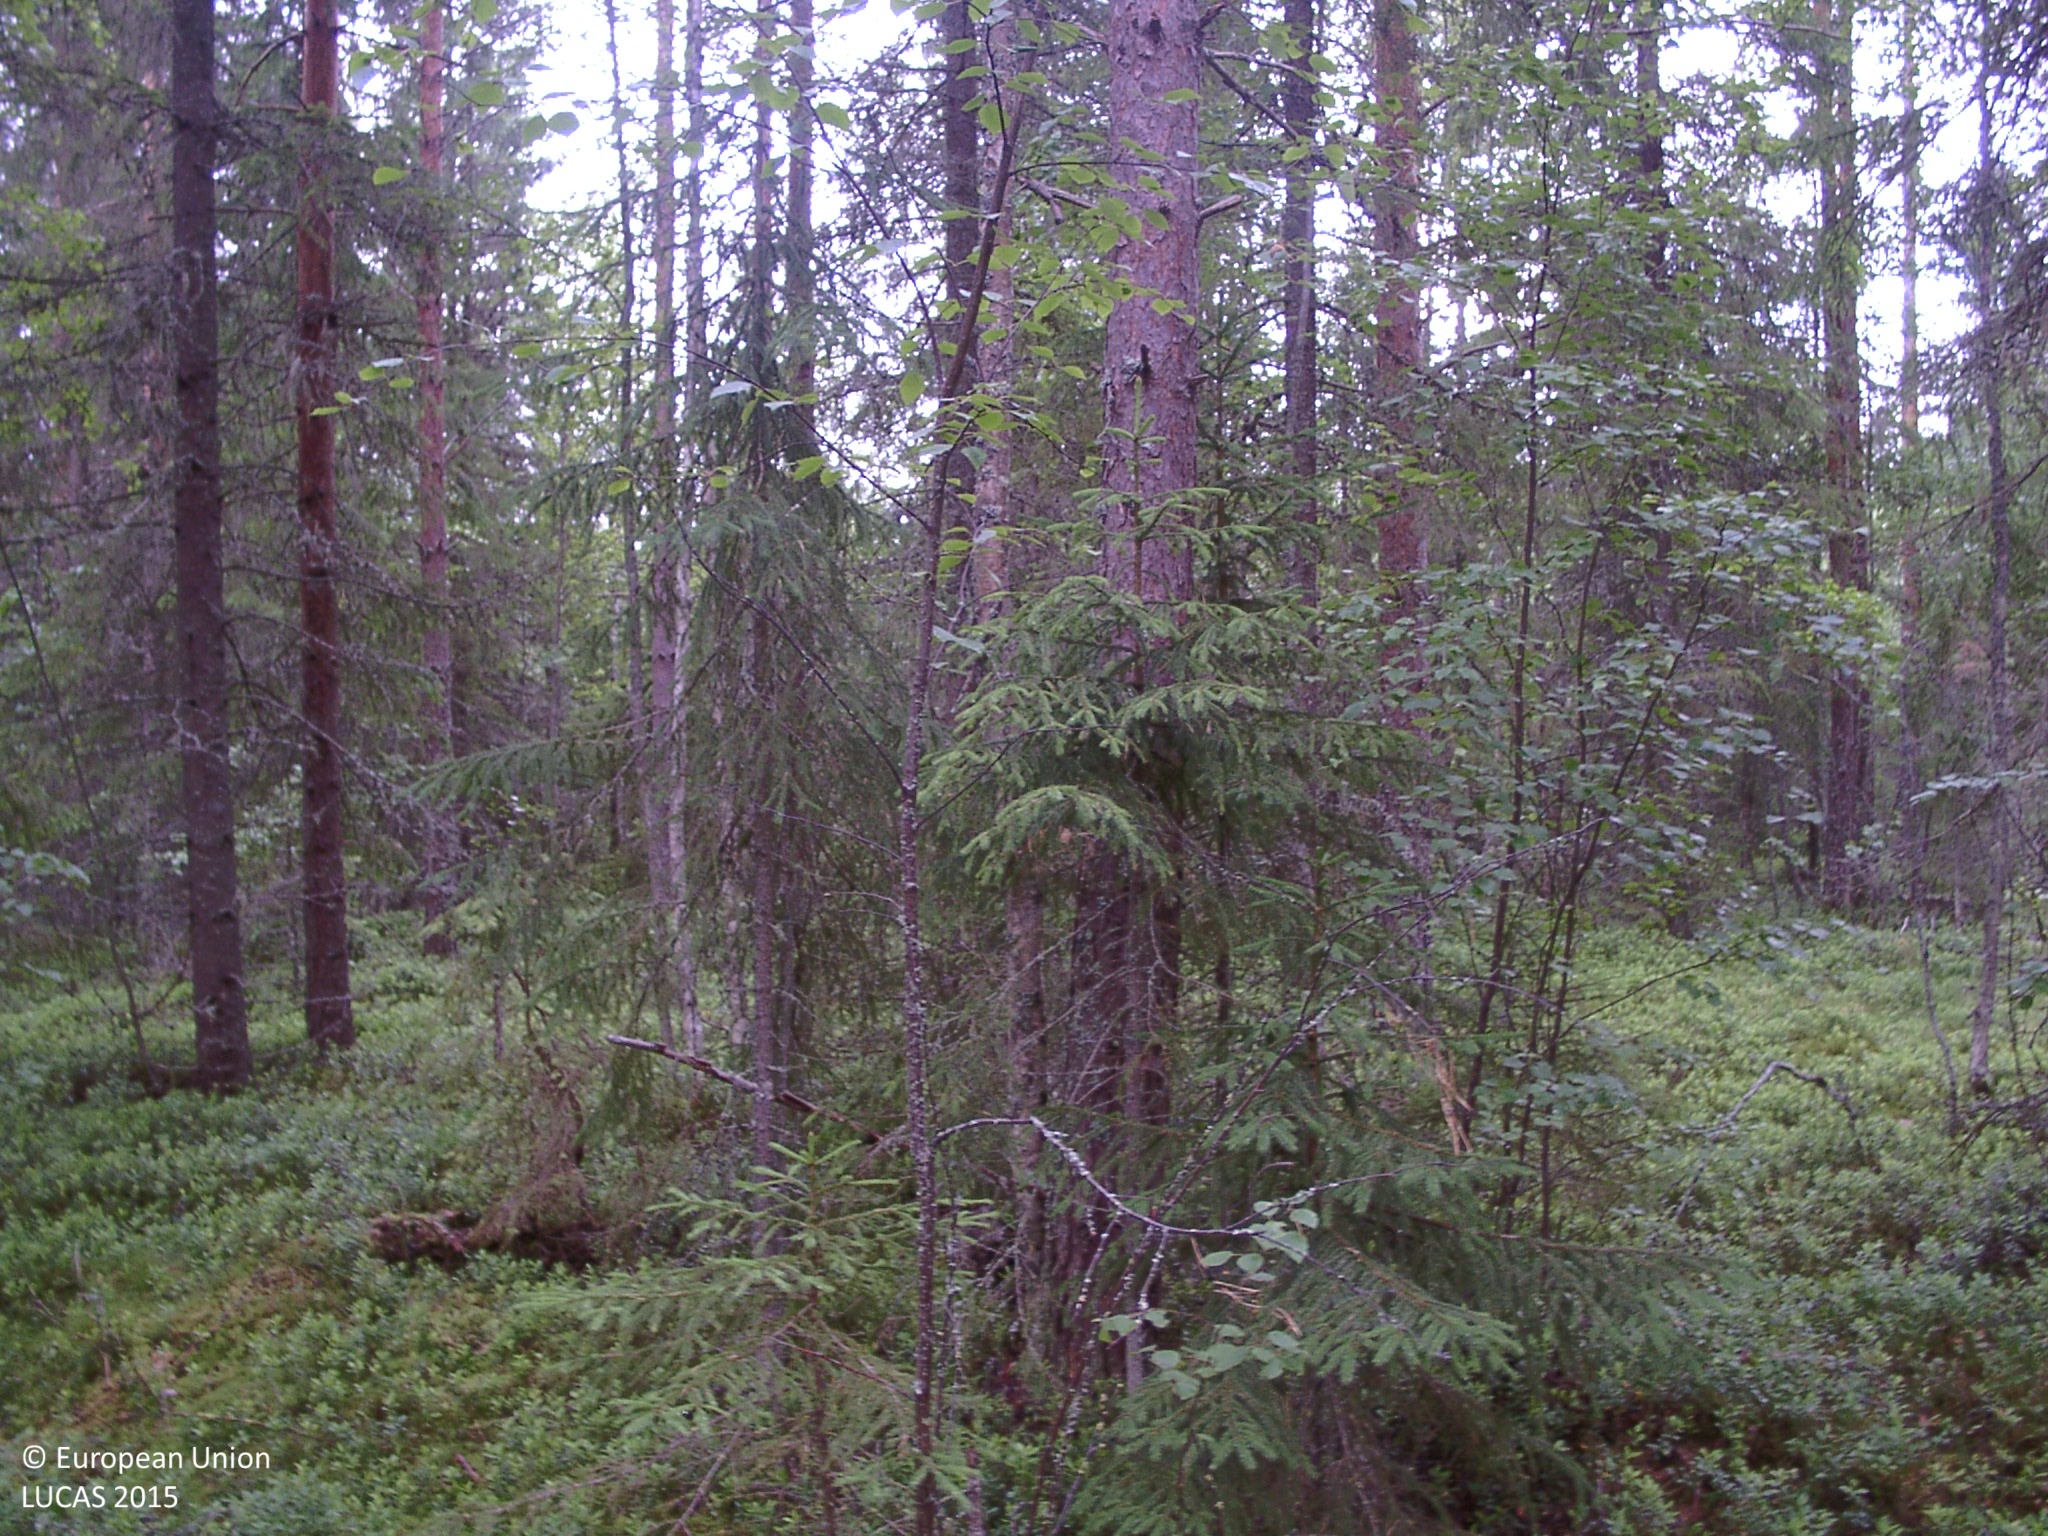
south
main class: Woodland
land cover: Other mixed woodland
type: boreal forest
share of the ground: 50 - 75 %
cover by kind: coniferous forest trees 50 %, shrubs 25 %, broadleaved forest trees 20 %, lichens and mosses 5 %
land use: Forestry
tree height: > 5 m
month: July
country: FI
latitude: 62.0919
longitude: 25.3765
